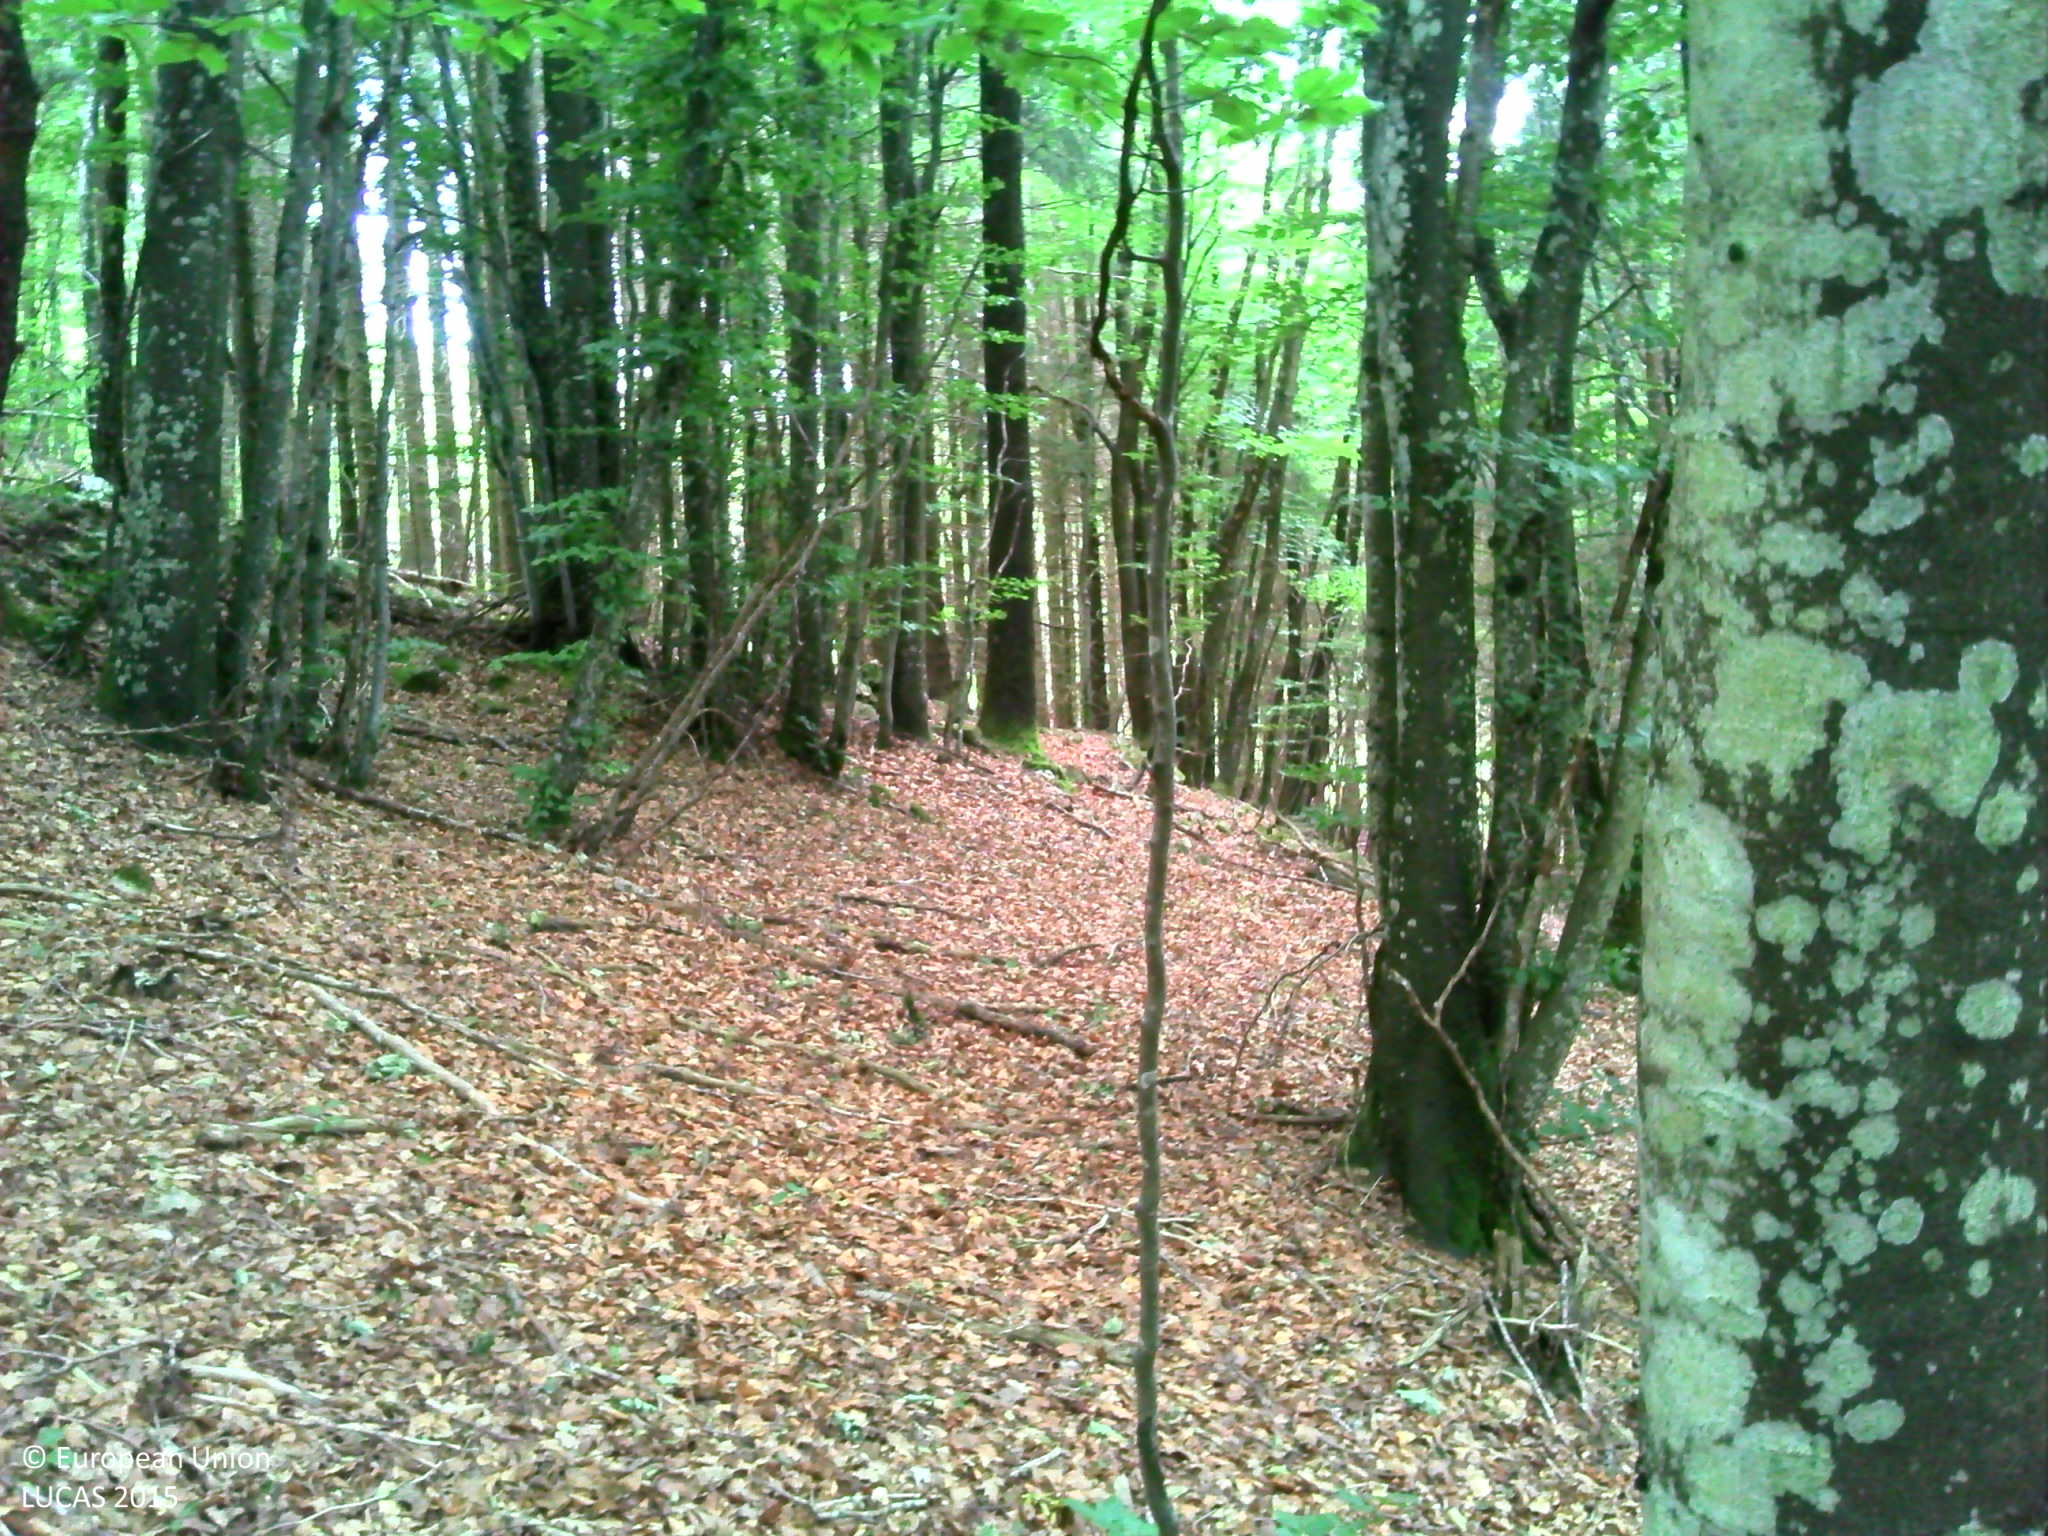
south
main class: Woodland
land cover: Broadleaved woodland
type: beech forest
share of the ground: > 75 %
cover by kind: broadleaved forest trees 80 %, unconsolidated bare surface 20 %
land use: Forestry
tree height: > 5 m
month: July
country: FR
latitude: 43.6913
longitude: 2.6494
